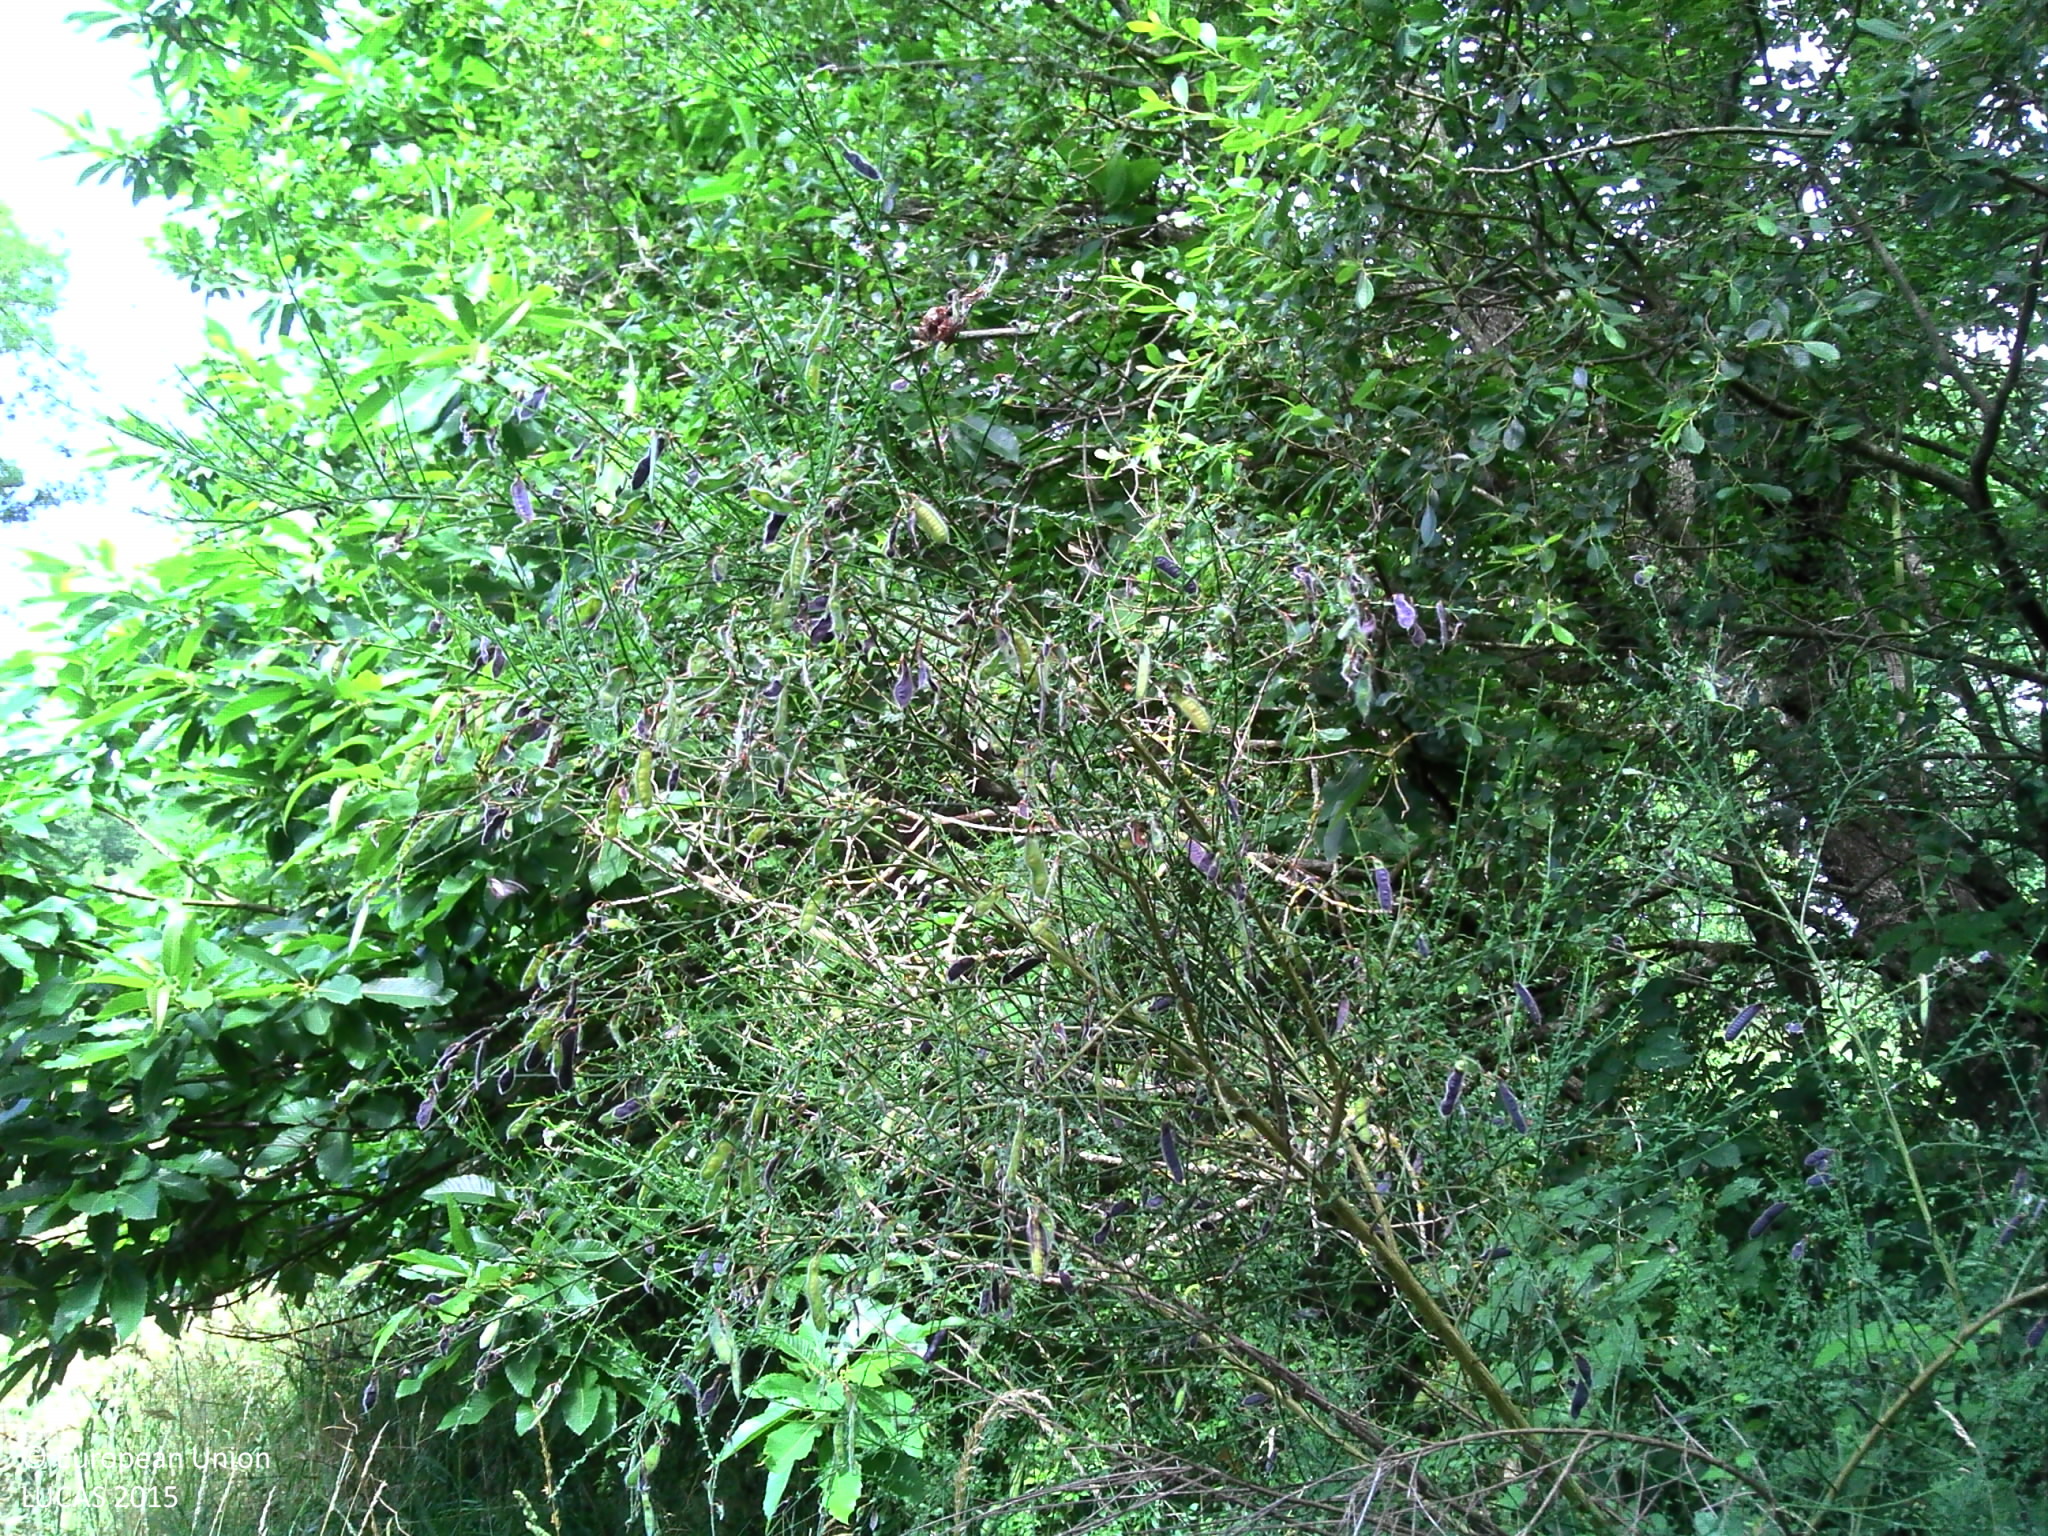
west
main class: Woodland
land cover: Broadleaved woodland
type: mesophytic deciduous forest
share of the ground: > 75 %
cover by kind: broadleaved forest trees 90 %, shrubs 5 %, herbaceous plants 5 %
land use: Forestry
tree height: > 5 m
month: June
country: FR
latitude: 46.3745
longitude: 3.2773
